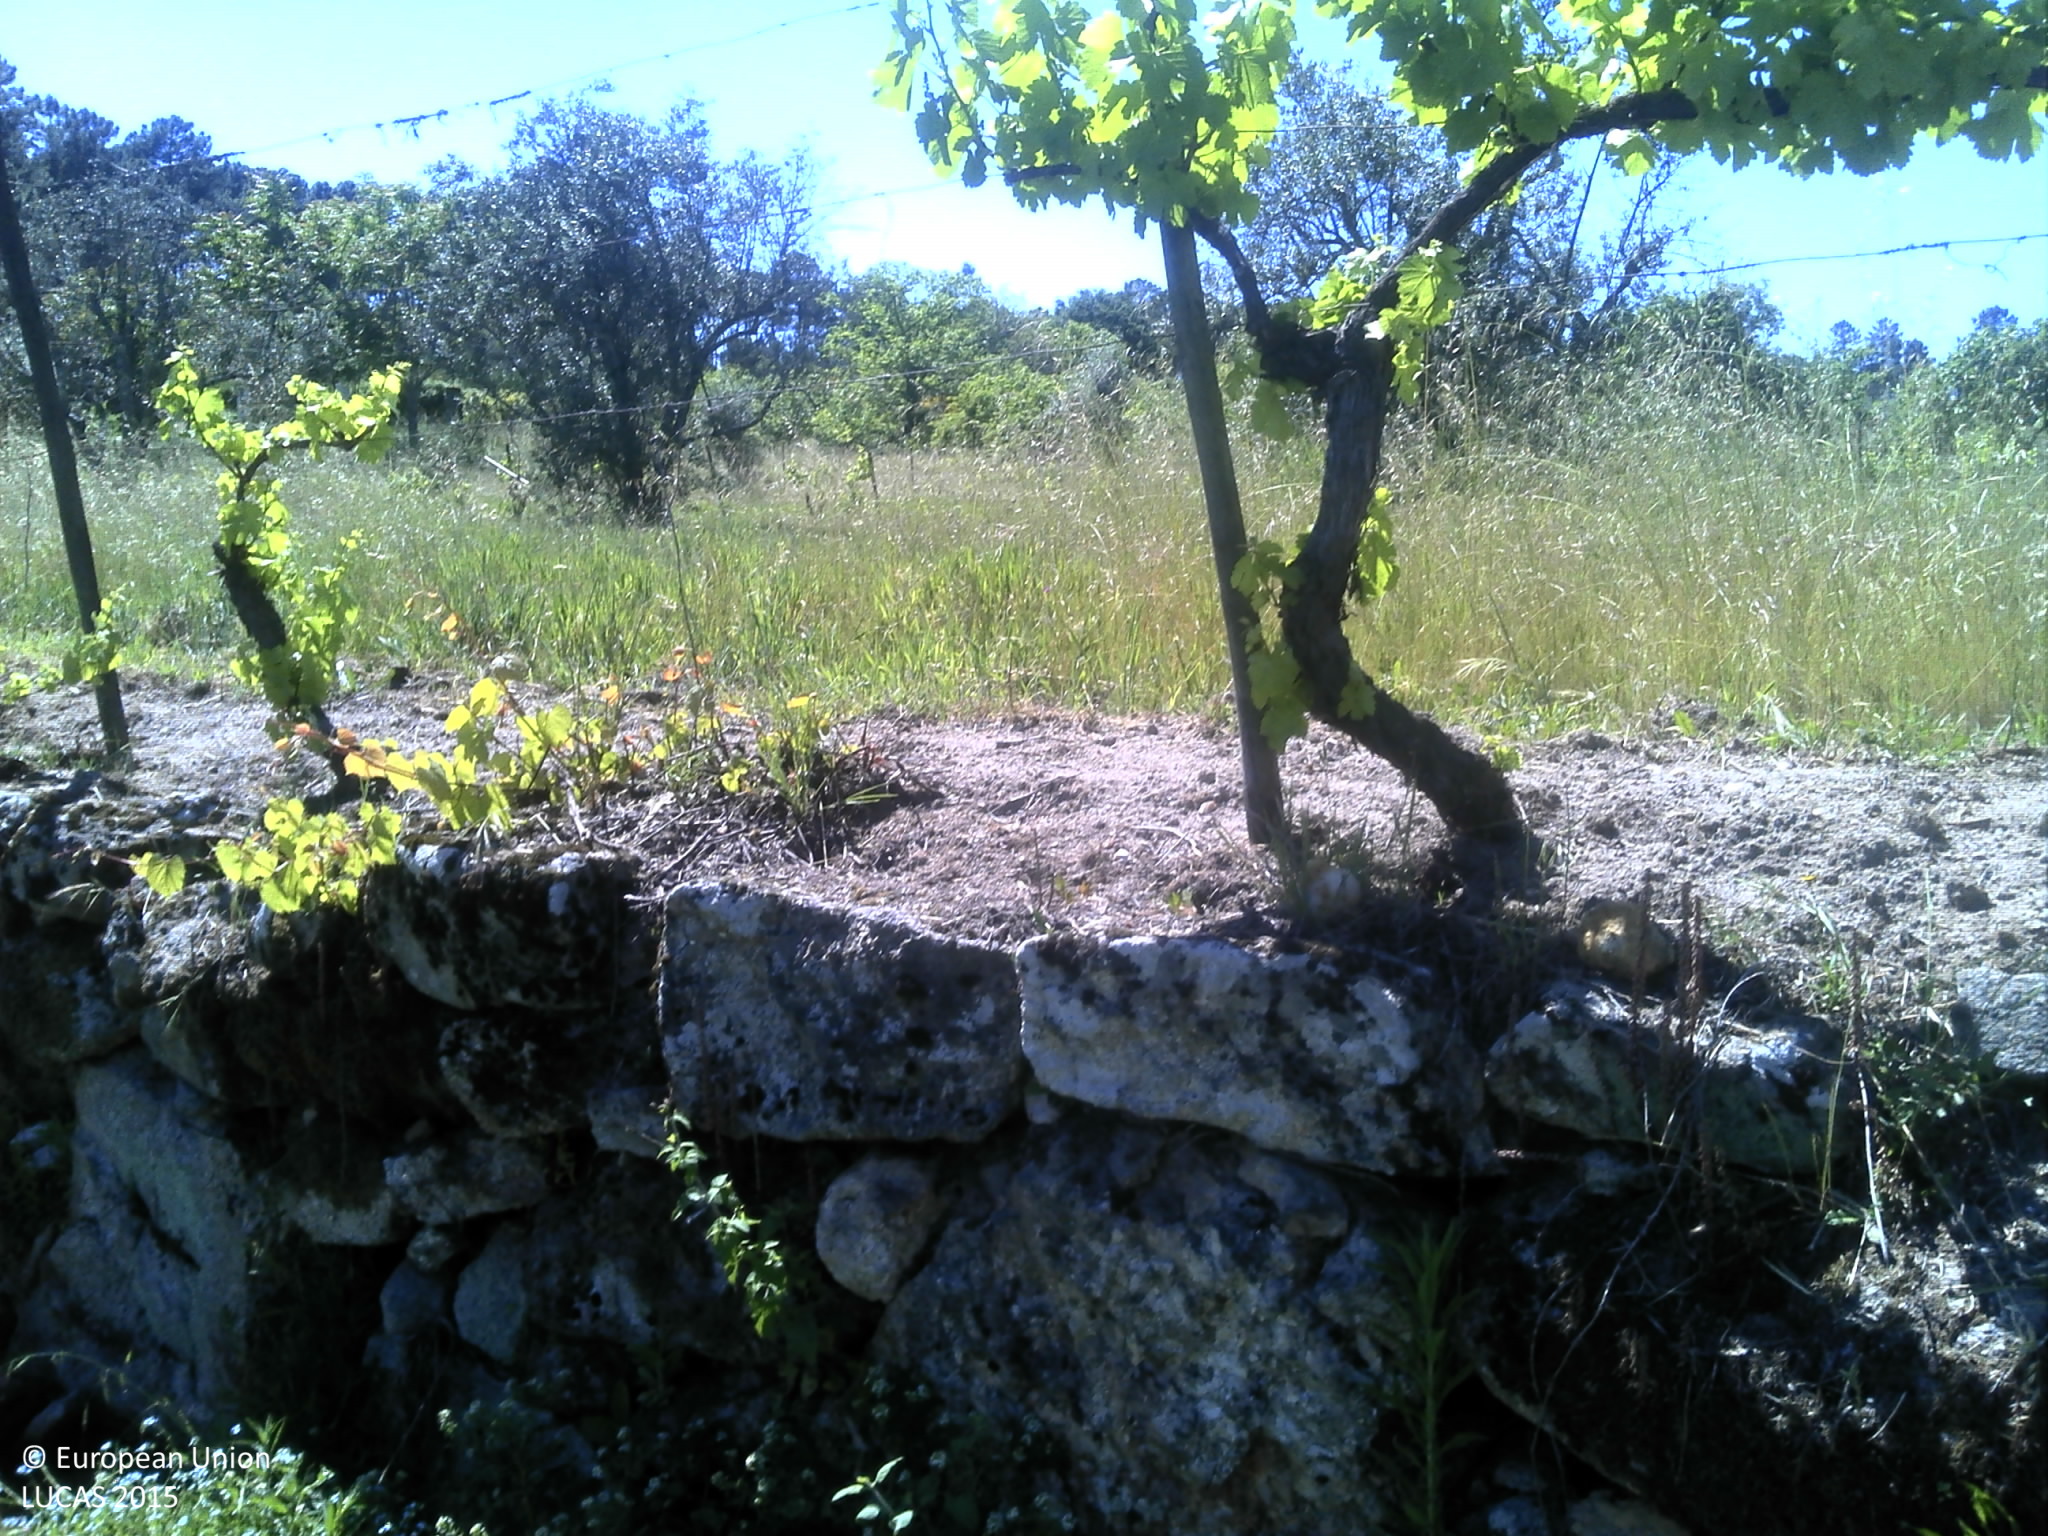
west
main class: Grassland
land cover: Grassland without tree/shrub cover
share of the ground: > 75 %
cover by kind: herbaceous plants 95 %, unconsolidated bare surface 5 %
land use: Agriculture (excluding fallow land and kitchen gardens)
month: May
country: PT
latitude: 40.5547
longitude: -7.7497
